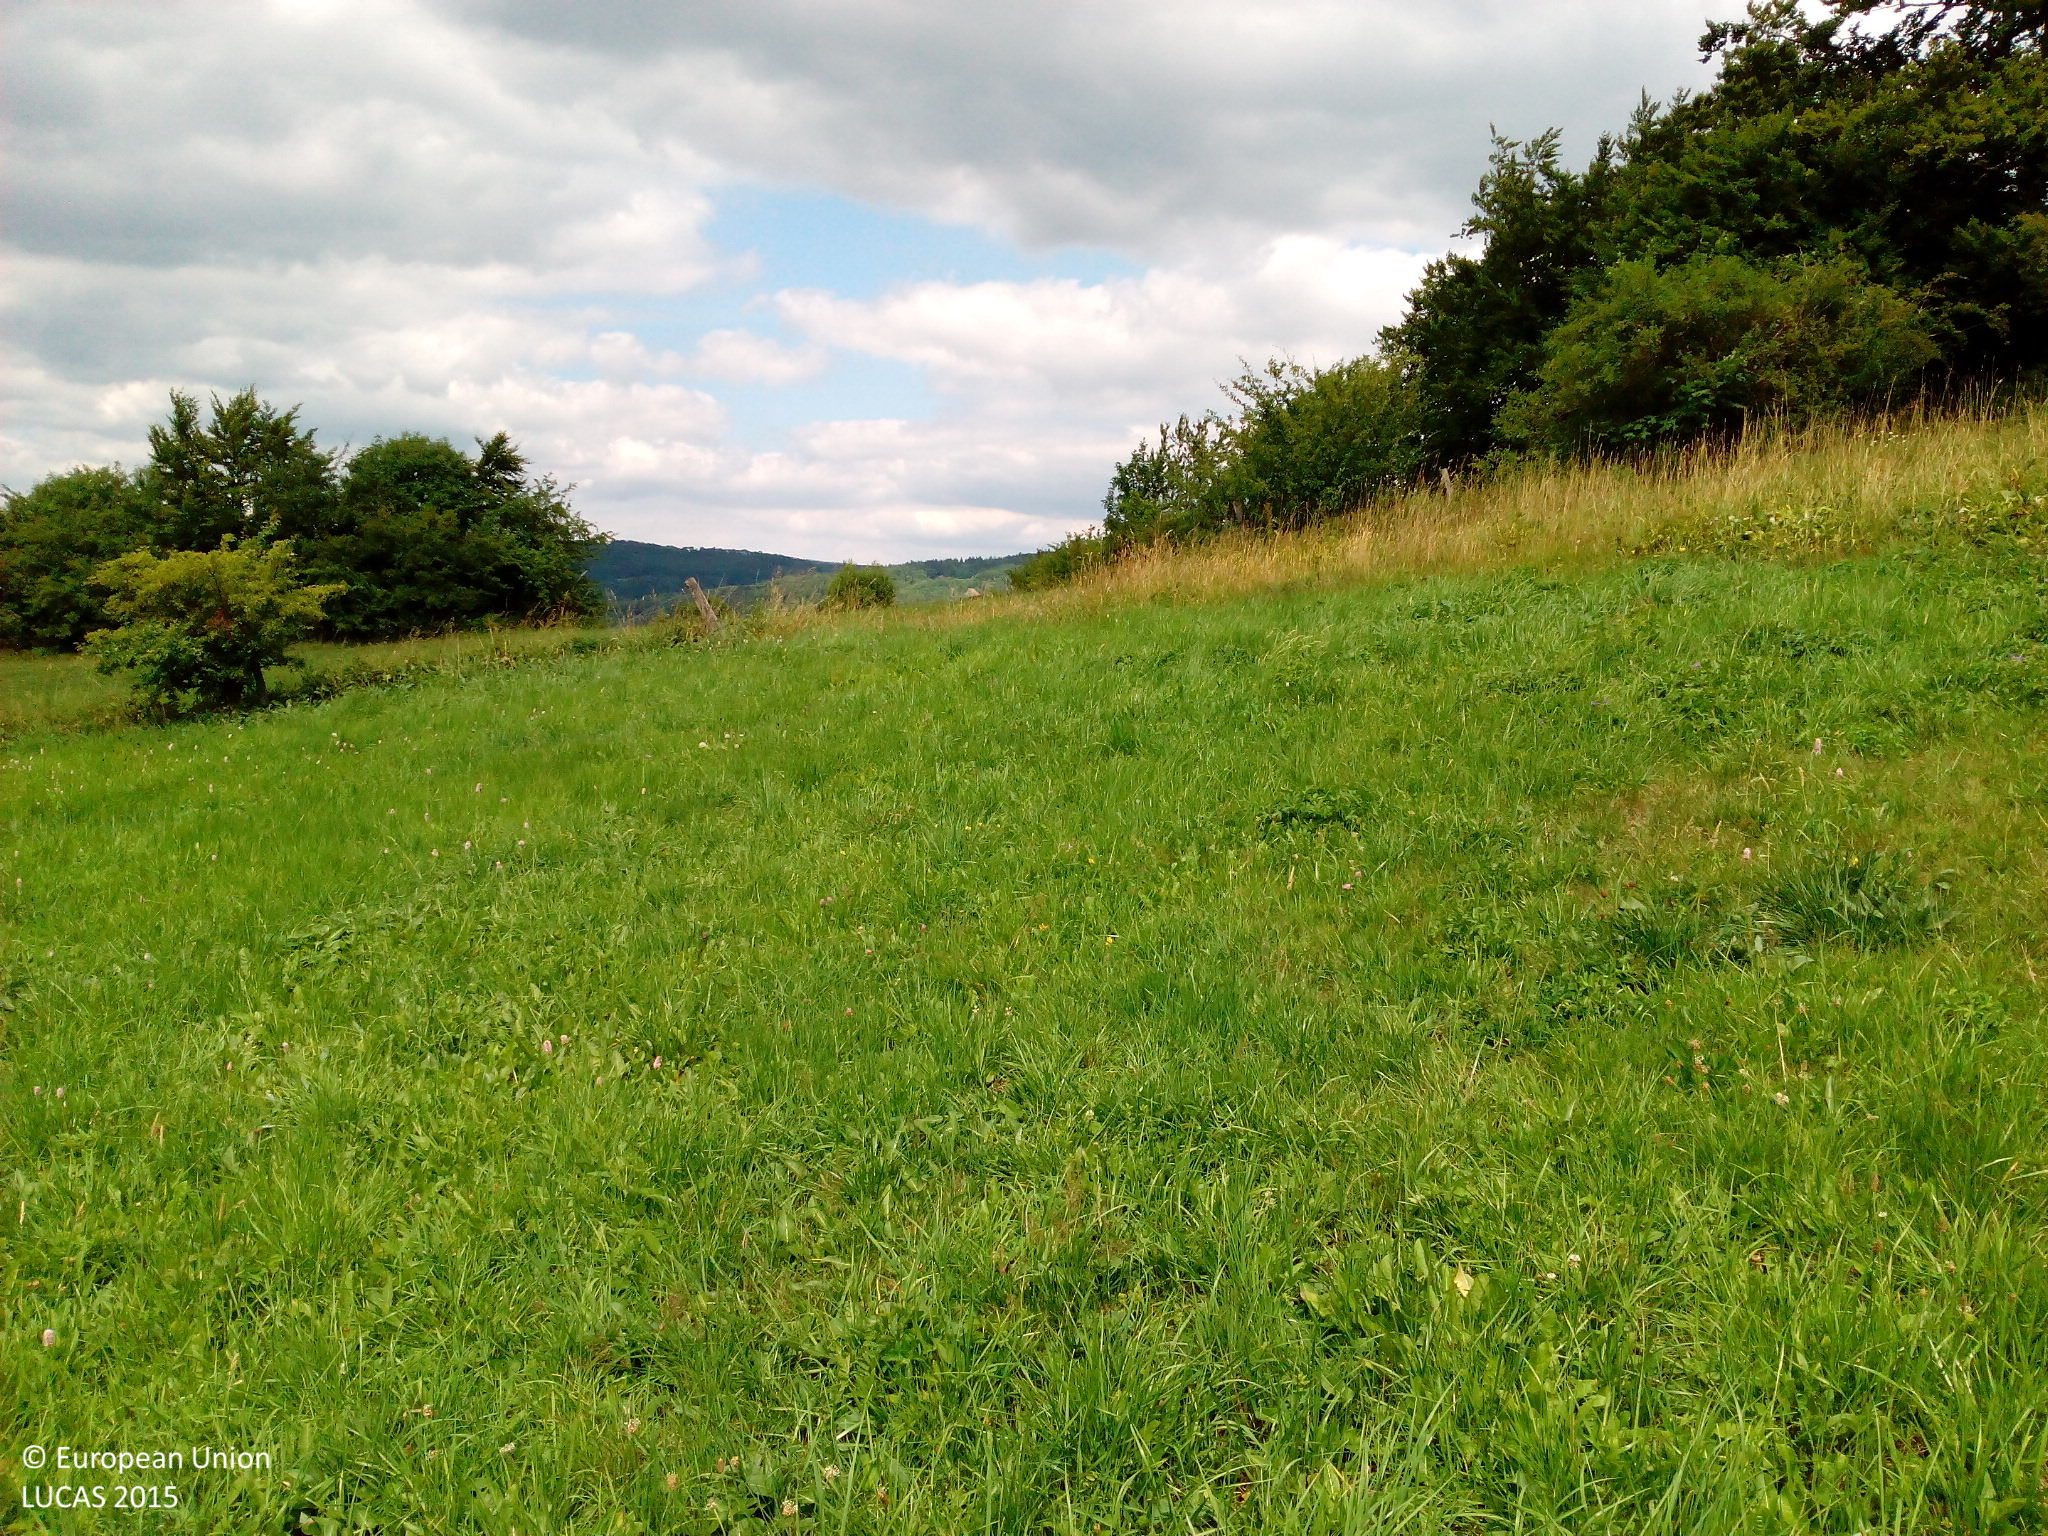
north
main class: Grassland
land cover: Grassland without tree/shrub cover
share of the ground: > 75 %
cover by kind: herbaceous plants 100 %
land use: Agriculture (excluding fallow land and kitchen gardens)
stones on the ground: < 10 %
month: July
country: DE
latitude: 50.4360
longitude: 9.9578
